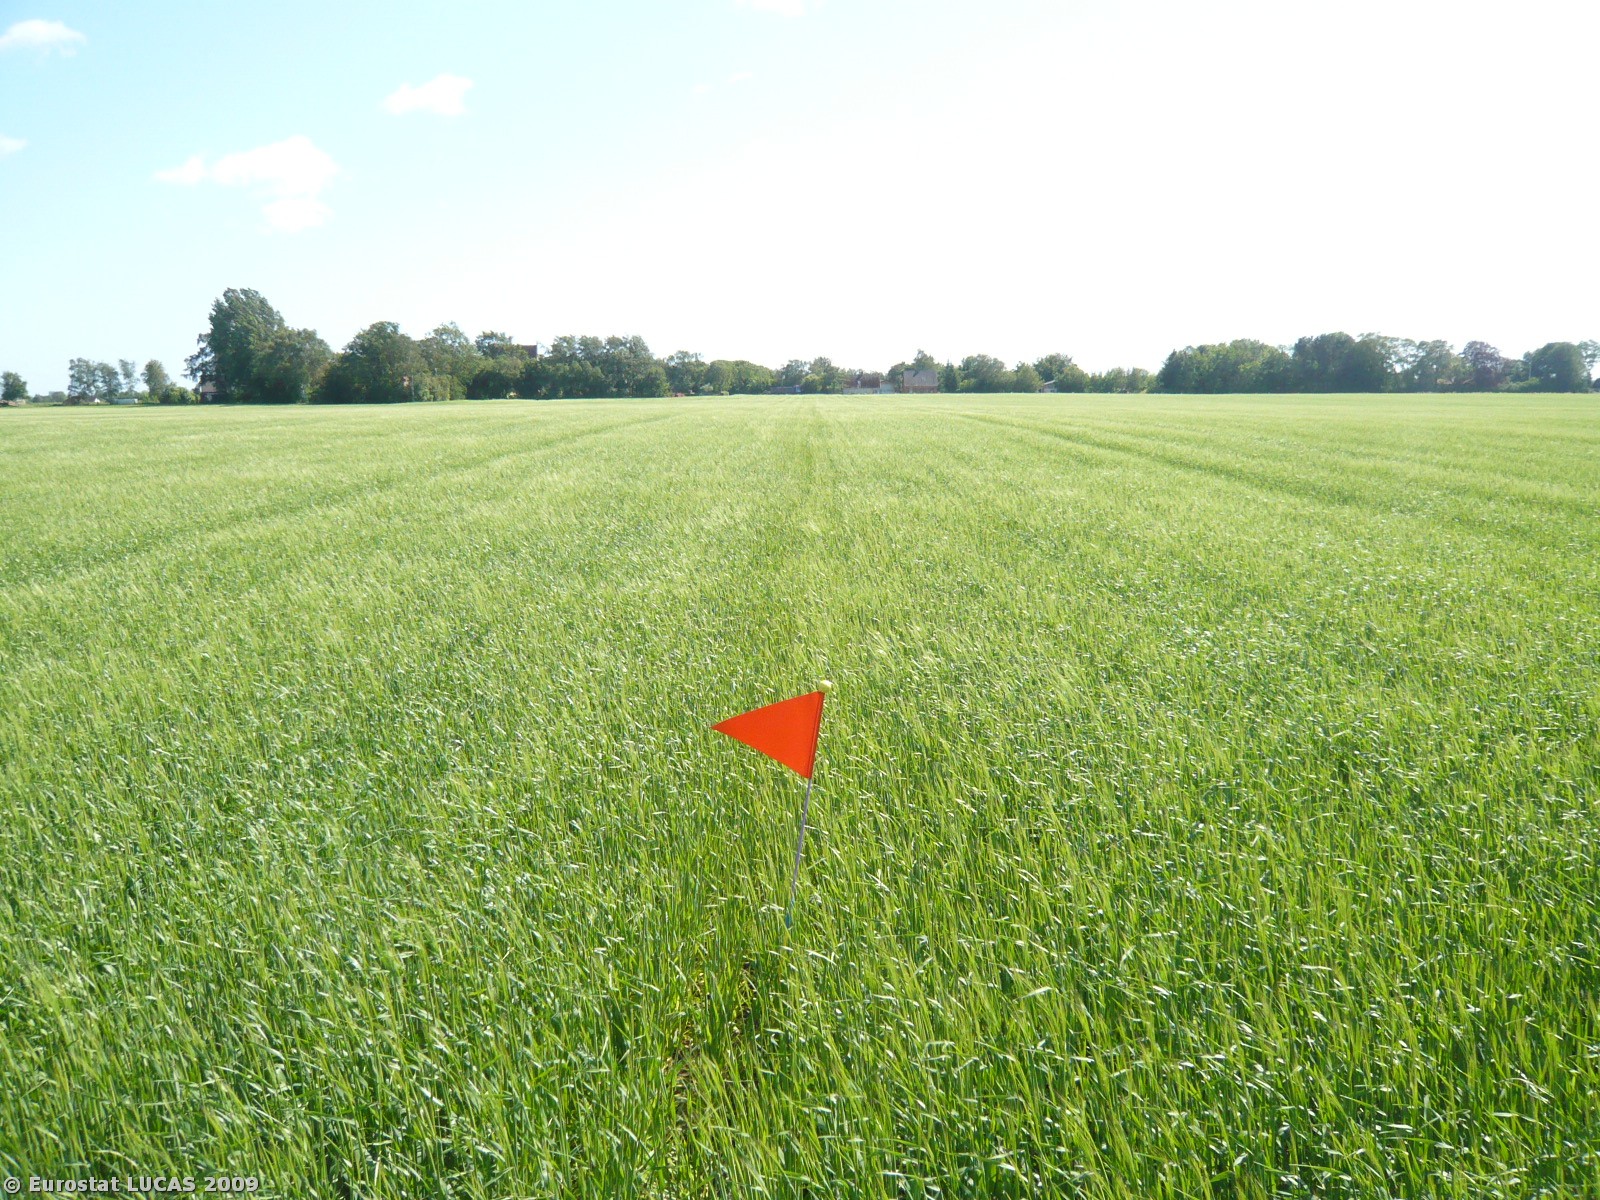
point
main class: Cropland
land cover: Barley
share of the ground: > 75 %
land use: Agriculture (excluding fallow land and kitchen gardens)
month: June
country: DK
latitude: 54.7797
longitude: 11.2274
